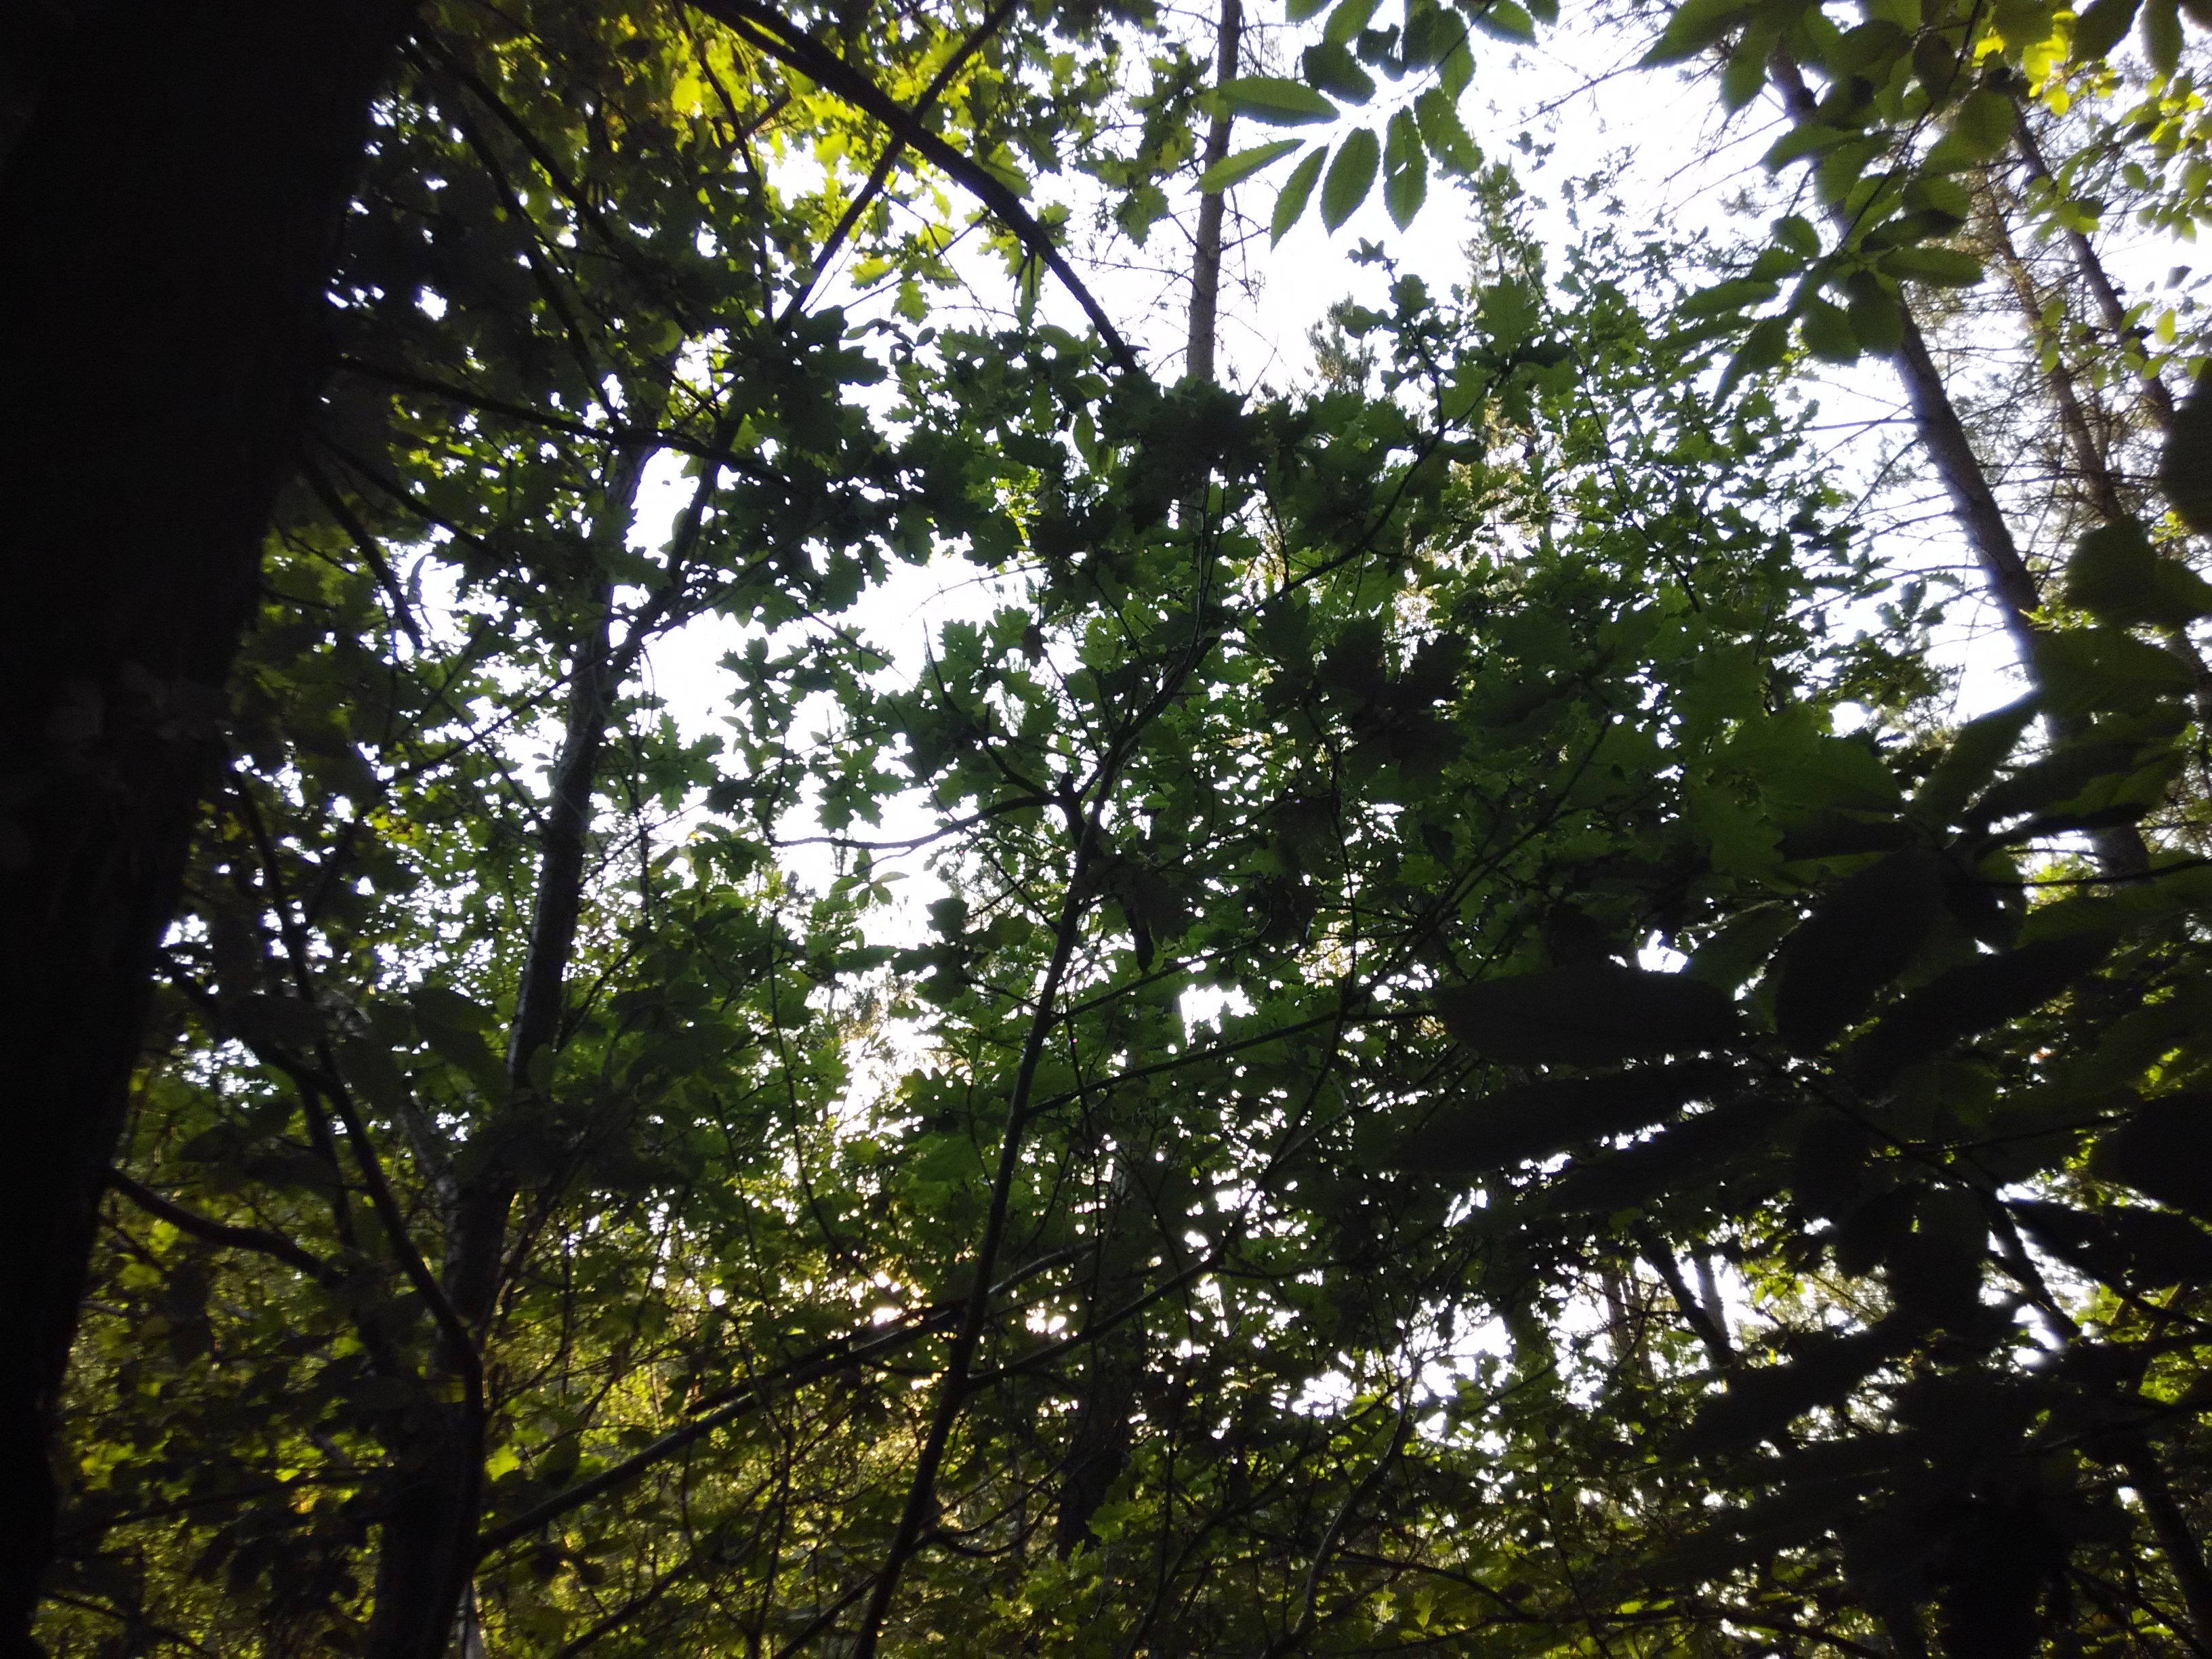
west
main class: Woodland
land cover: Other mixed woodland
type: acidophilous oak and oak-birch forest
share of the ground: > 75 %
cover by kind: coniferous forest trees 40 %, broadleaved forest trees 35 %, herbaceous plants 15 %, unconsolidated bare surface 10 %
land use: Forestry
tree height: > 5 m
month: June
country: ES
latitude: 43.0667
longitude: -2.4659
